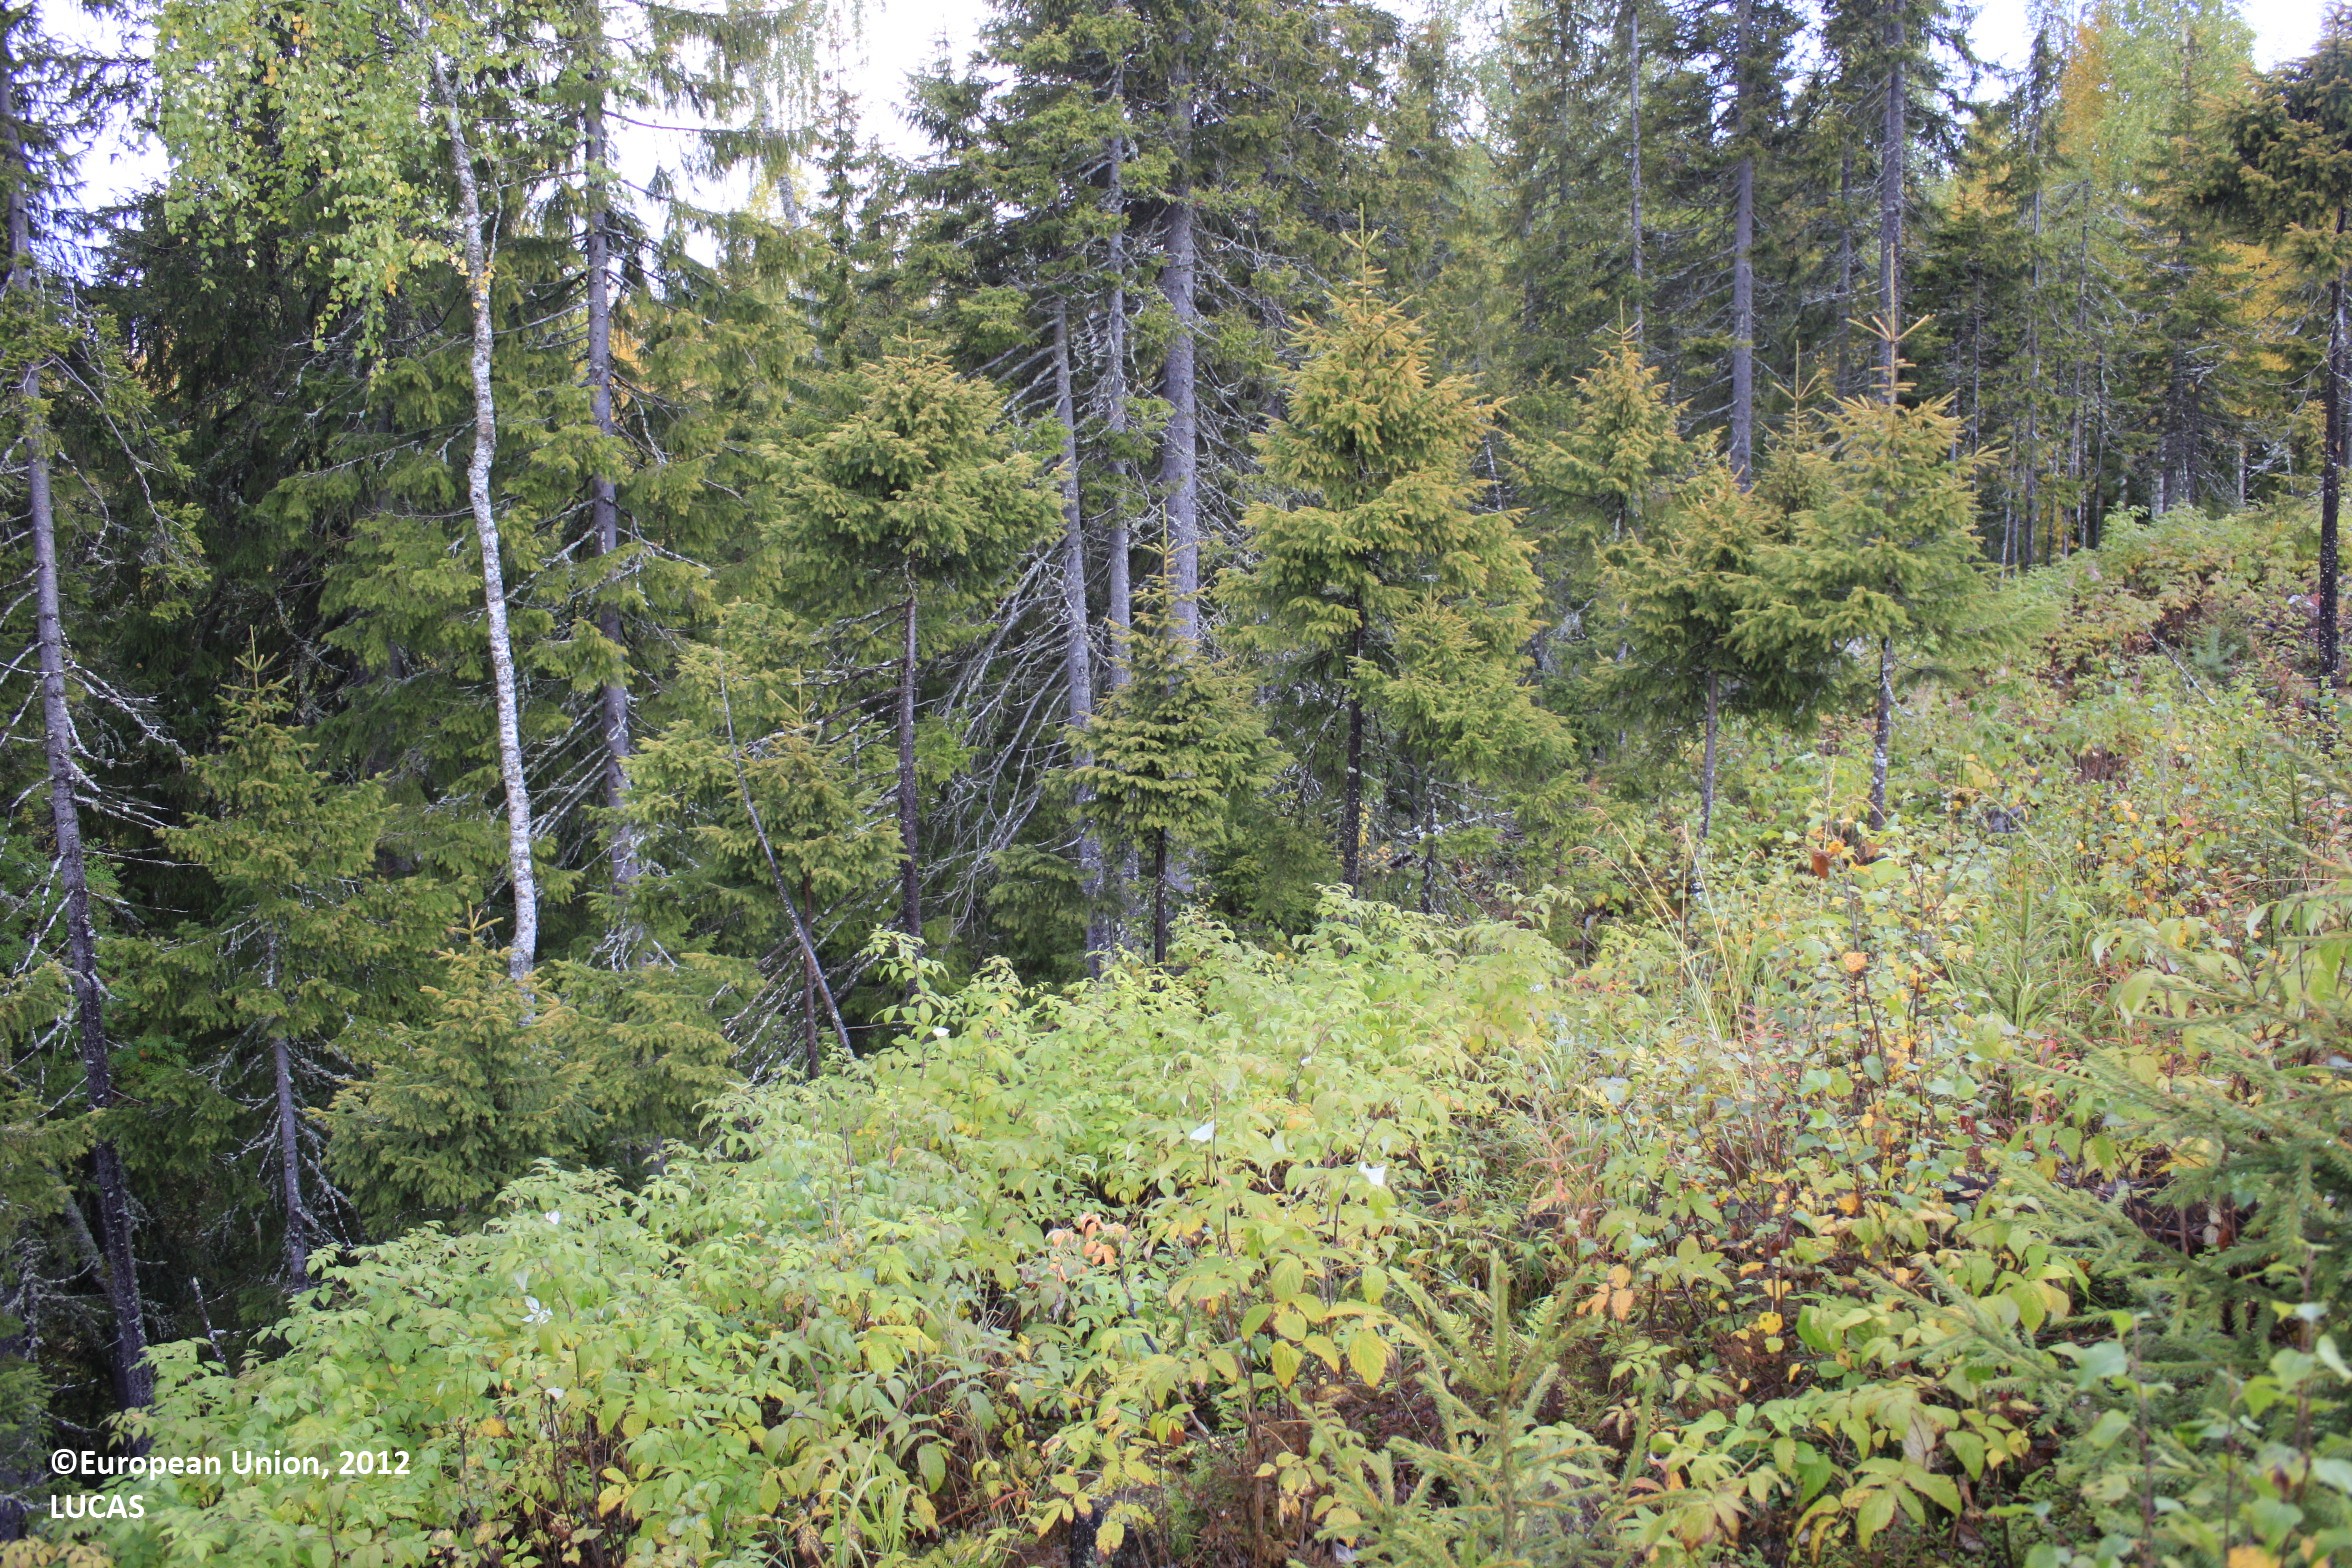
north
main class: Shrubland
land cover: Shrubland with sparse tree cover
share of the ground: > 75 %
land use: Forestry
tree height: < 5 m
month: September
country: FI
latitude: 65.6928
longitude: 27.4331
